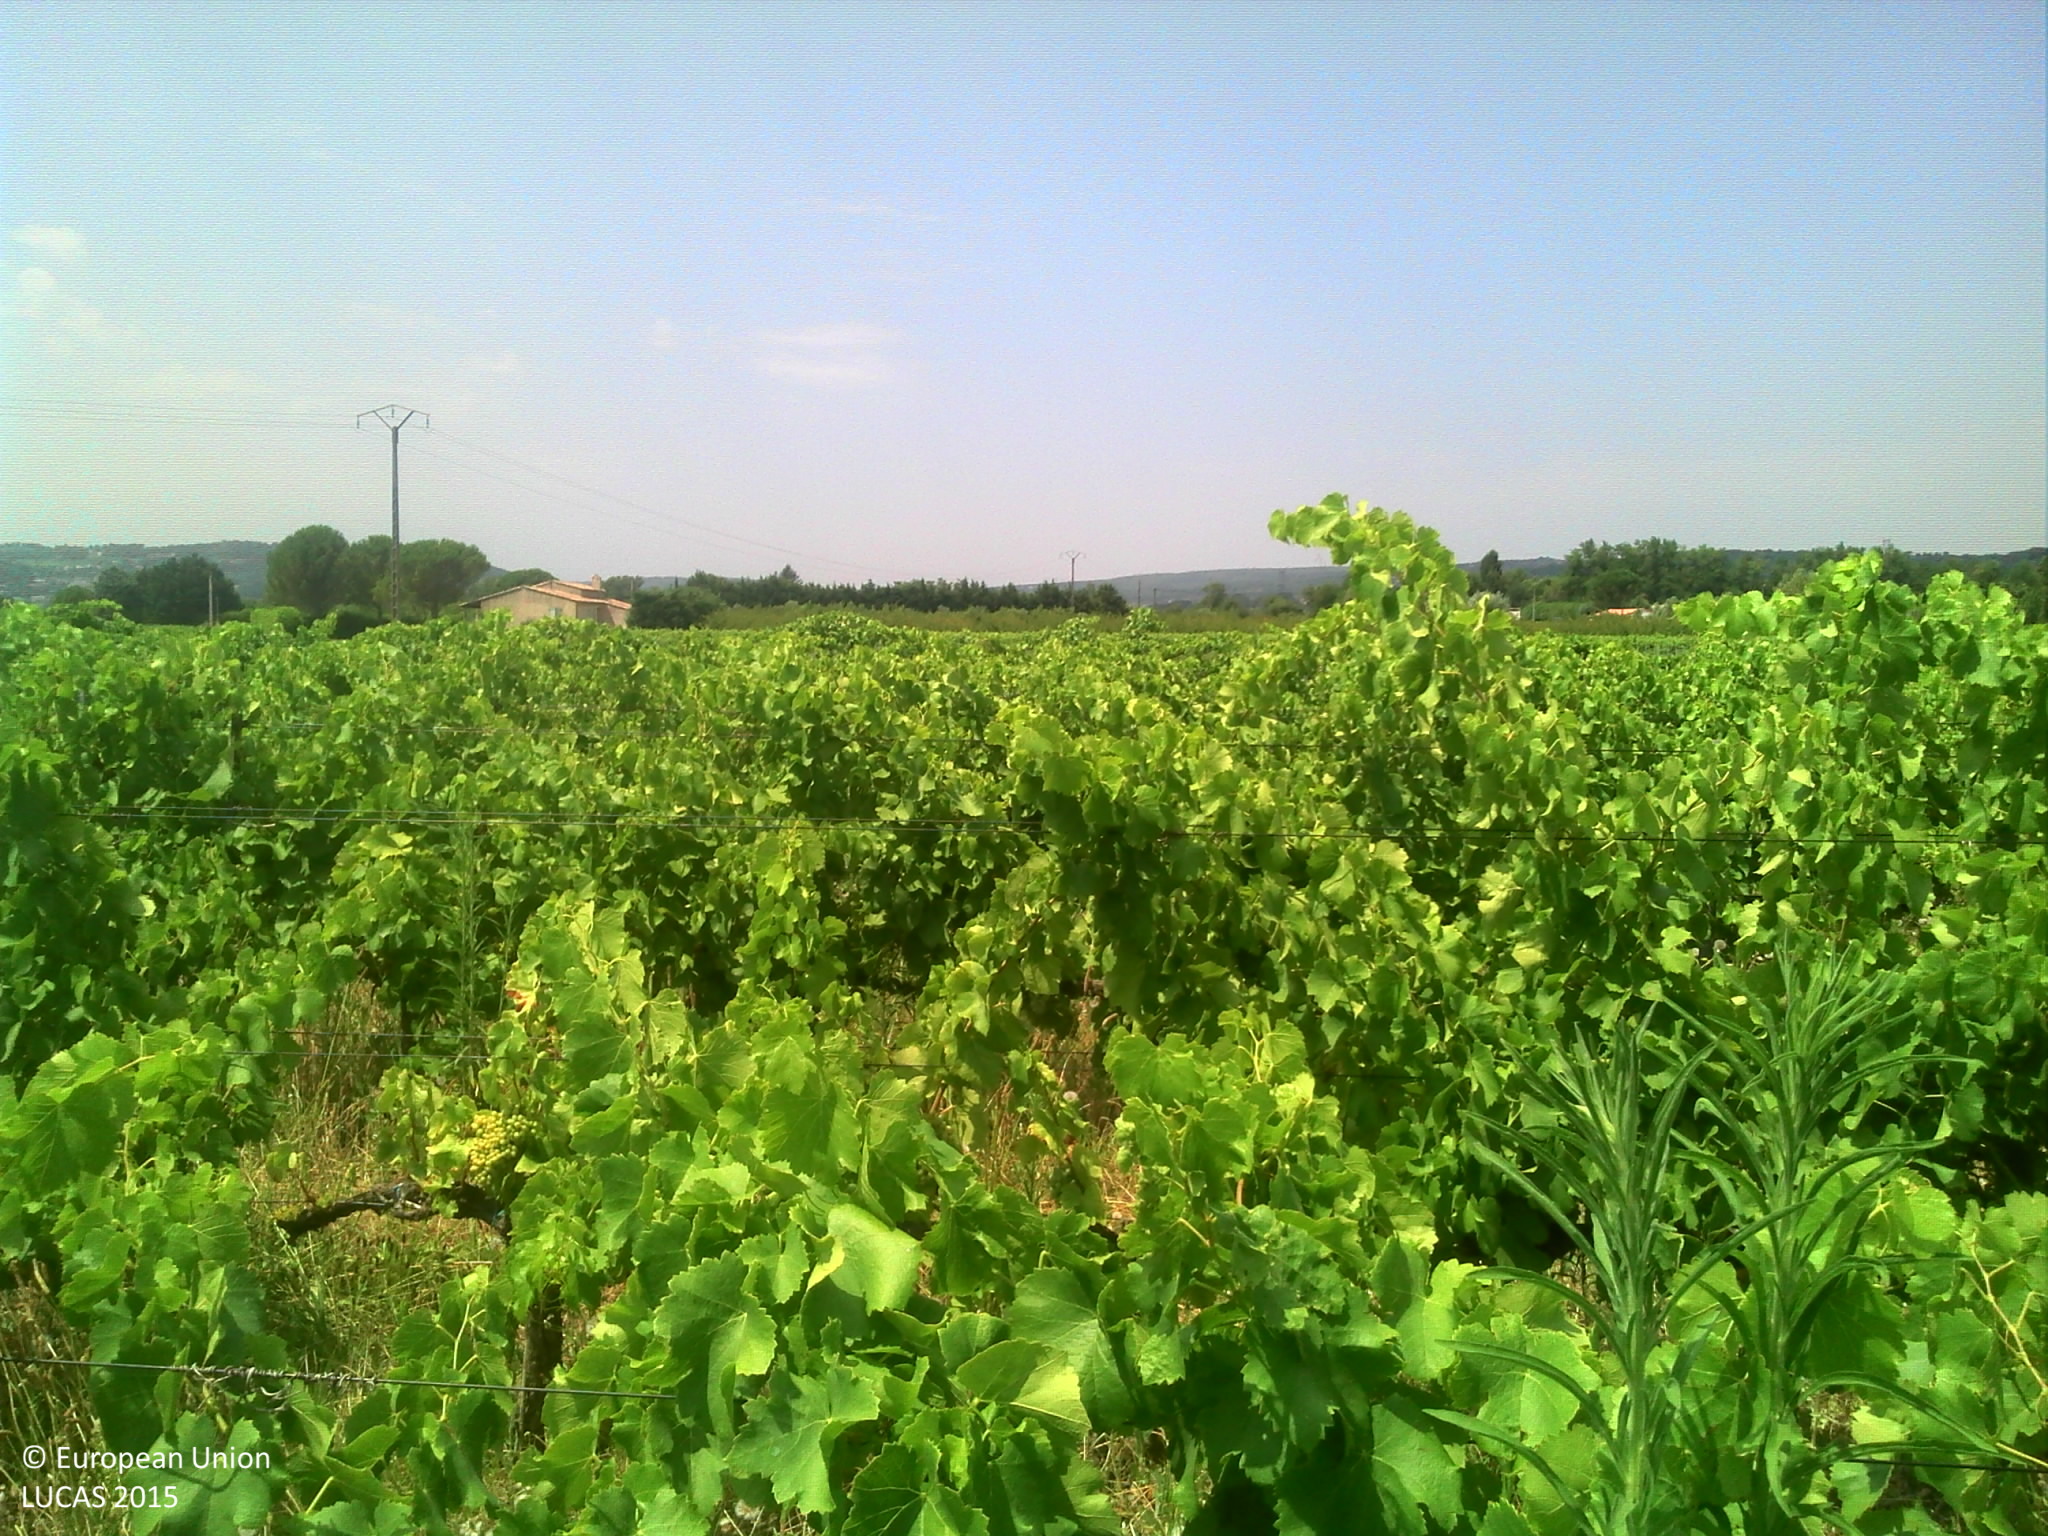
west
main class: Cropland
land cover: Vineyards
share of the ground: 50 - 75 %
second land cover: Grassland without tree/shrub cover
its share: 50 - 75 %
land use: Agriculture (excluding fallow land and kitchen gardens)
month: July
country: FR
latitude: 44.3006
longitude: 4.6051
